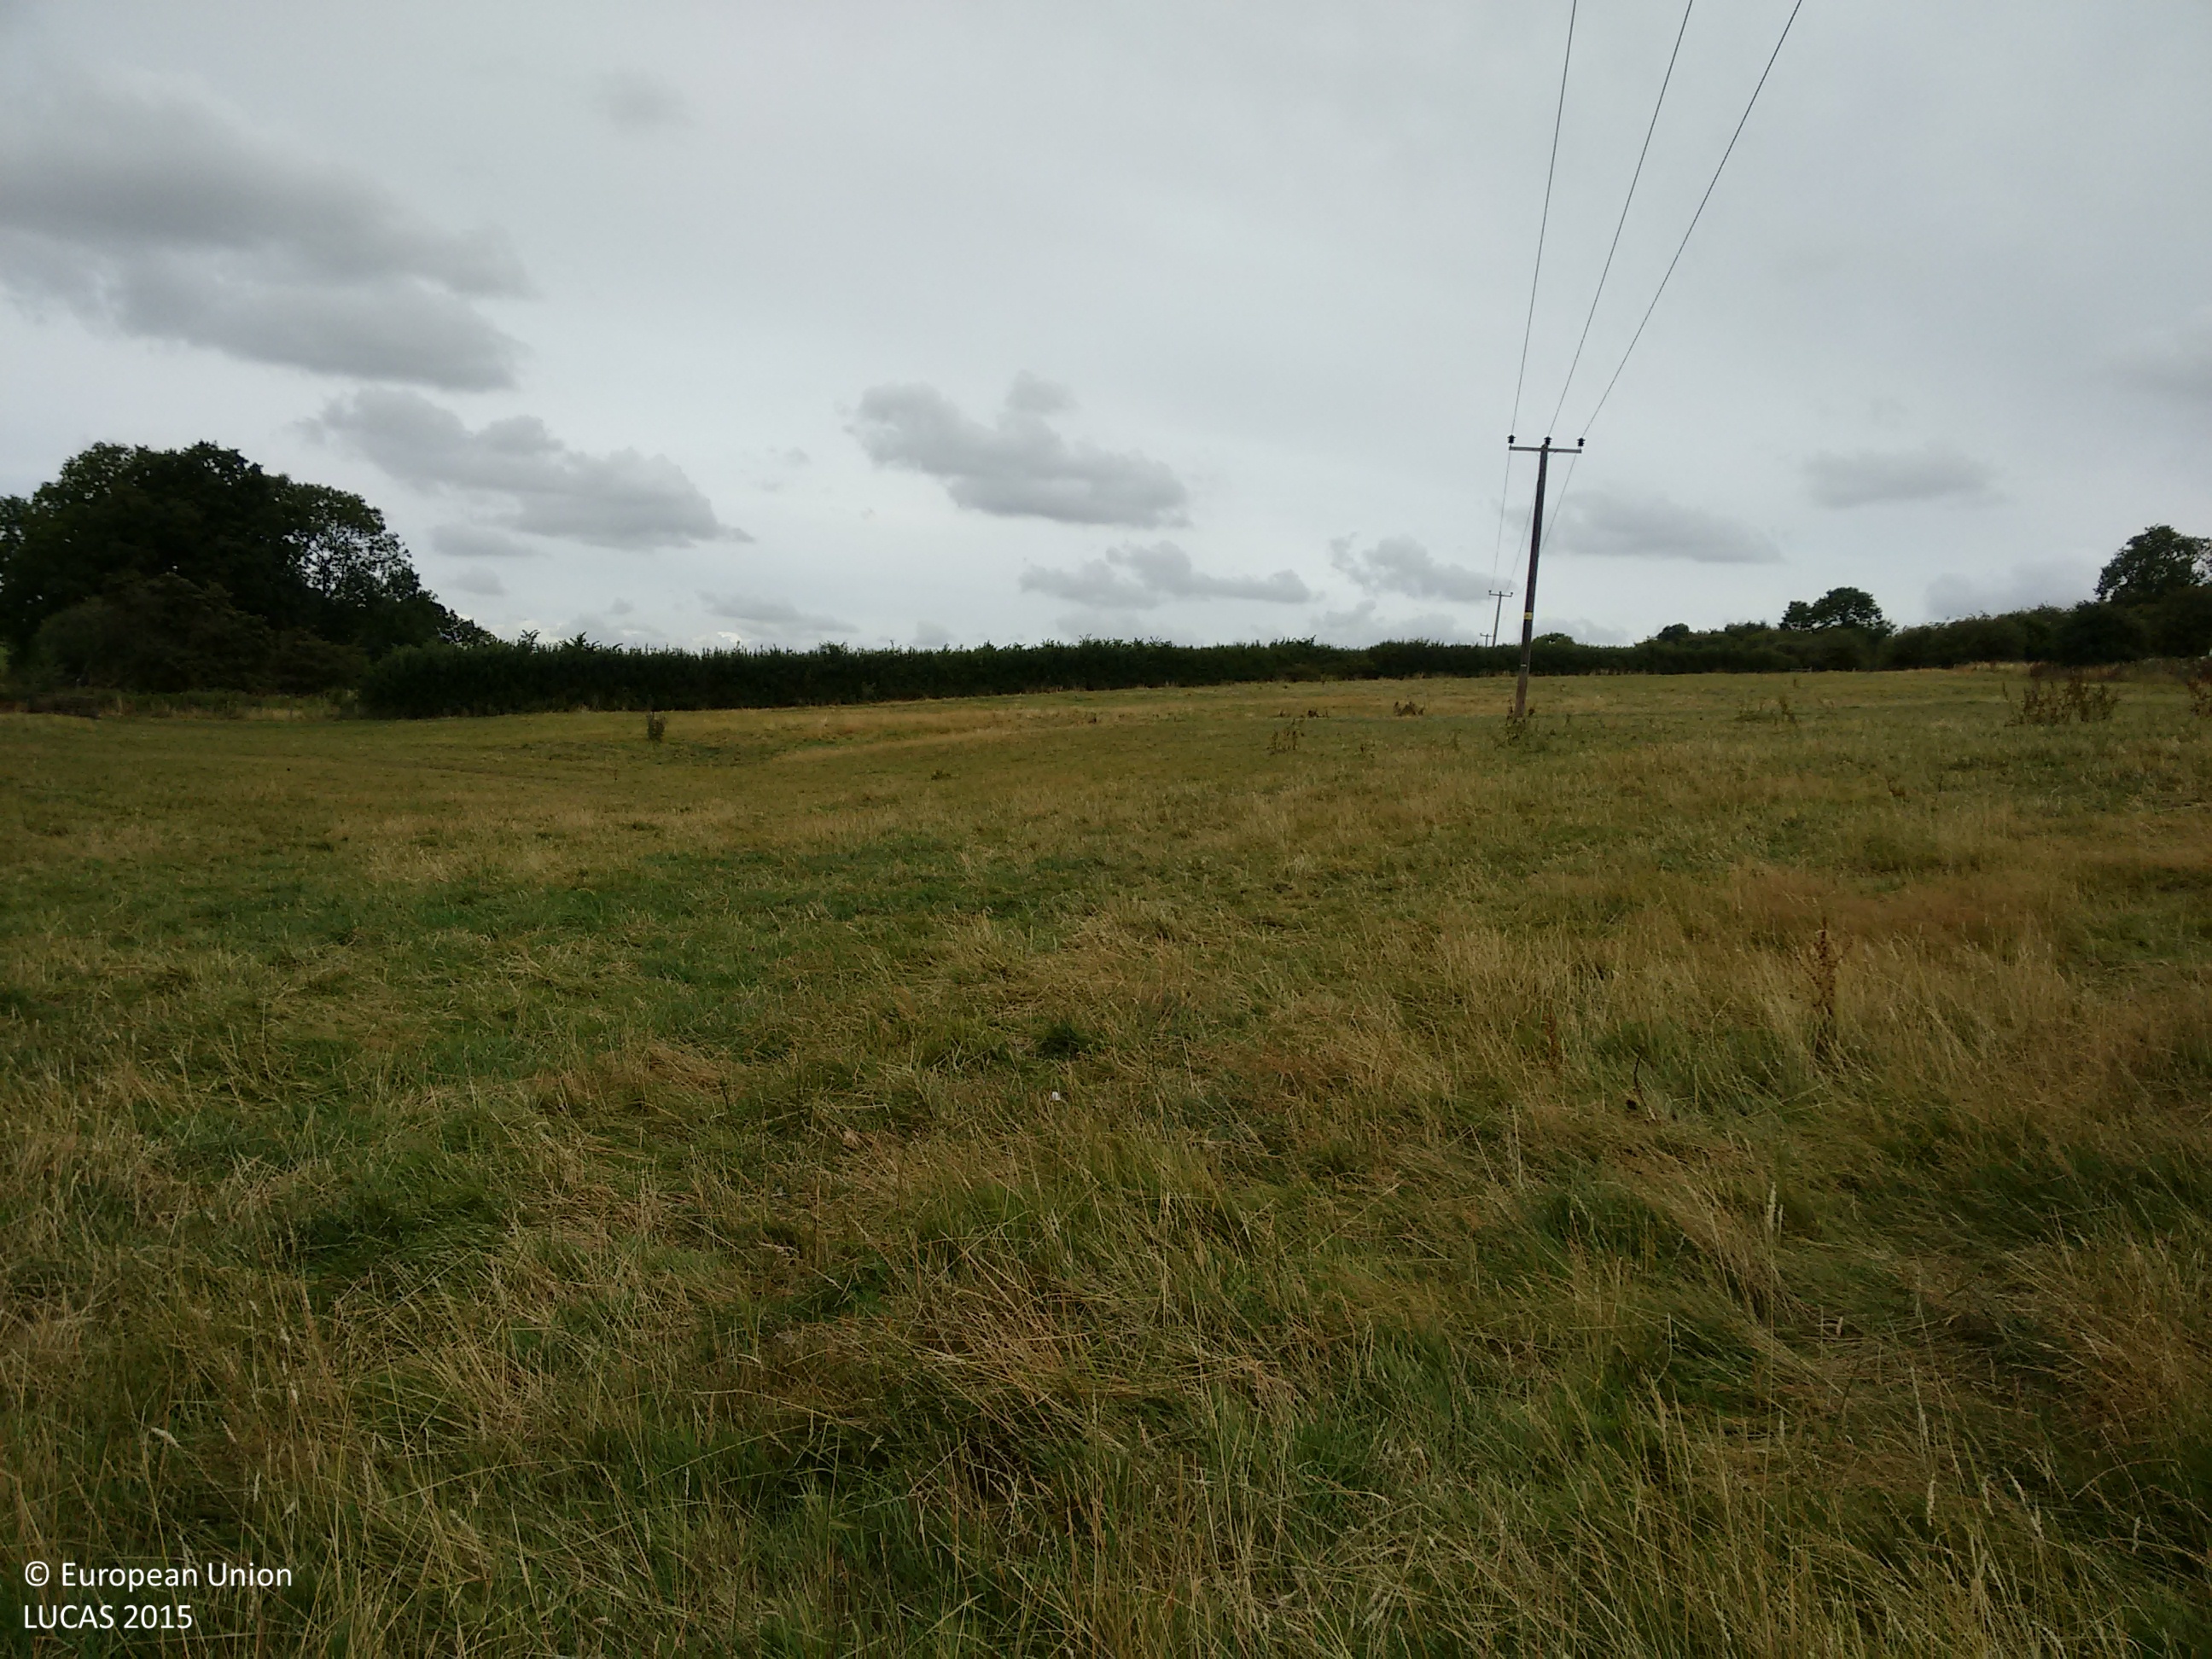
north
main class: Grassland
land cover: Grassland without tree/shrub cover
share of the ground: > 75 %
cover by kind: herbaceous plants 100 %
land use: Agriculture (excluding fallow land and kitchen gardens)
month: August
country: GB
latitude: 52.1161
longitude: -1.2191
